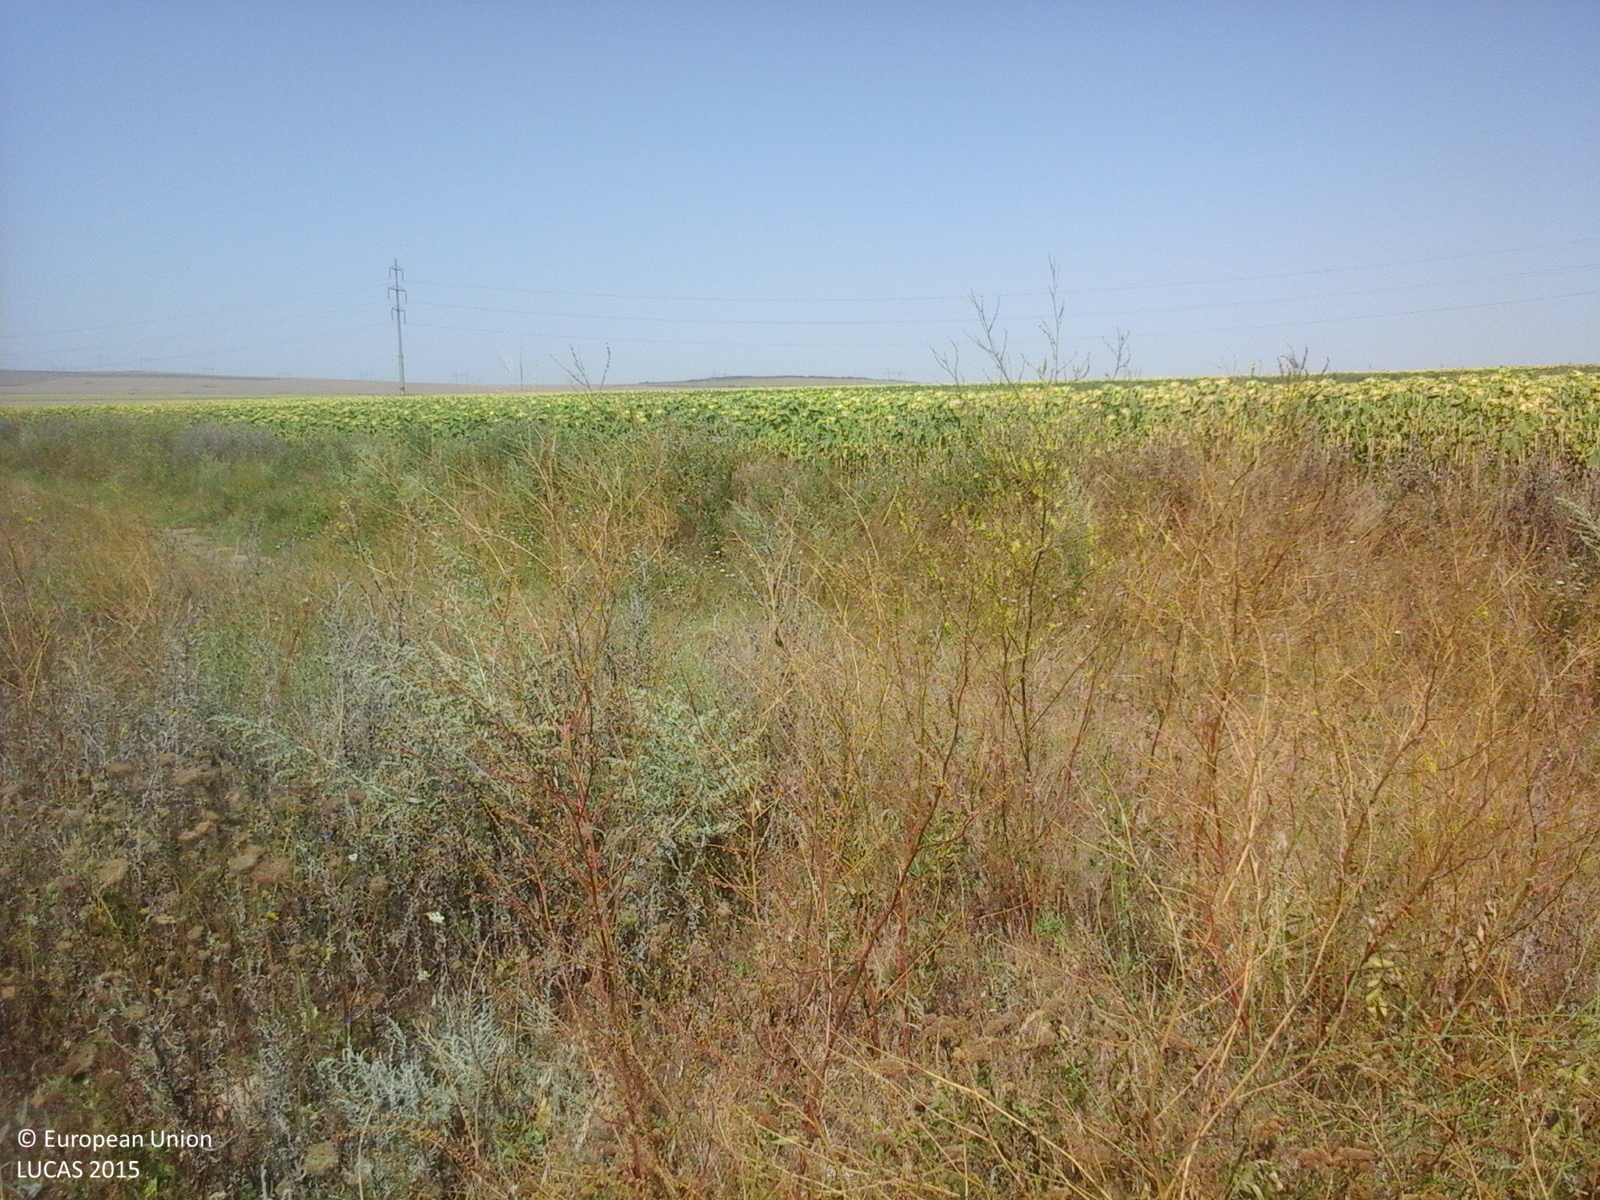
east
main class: Cropland
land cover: Sunflower
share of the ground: > 75 %
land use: Agriculture (excluding fallow land and kitchen gardens)
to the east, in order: Sunflower
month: August
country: RO
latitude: 44.5027
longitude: 28.1614
